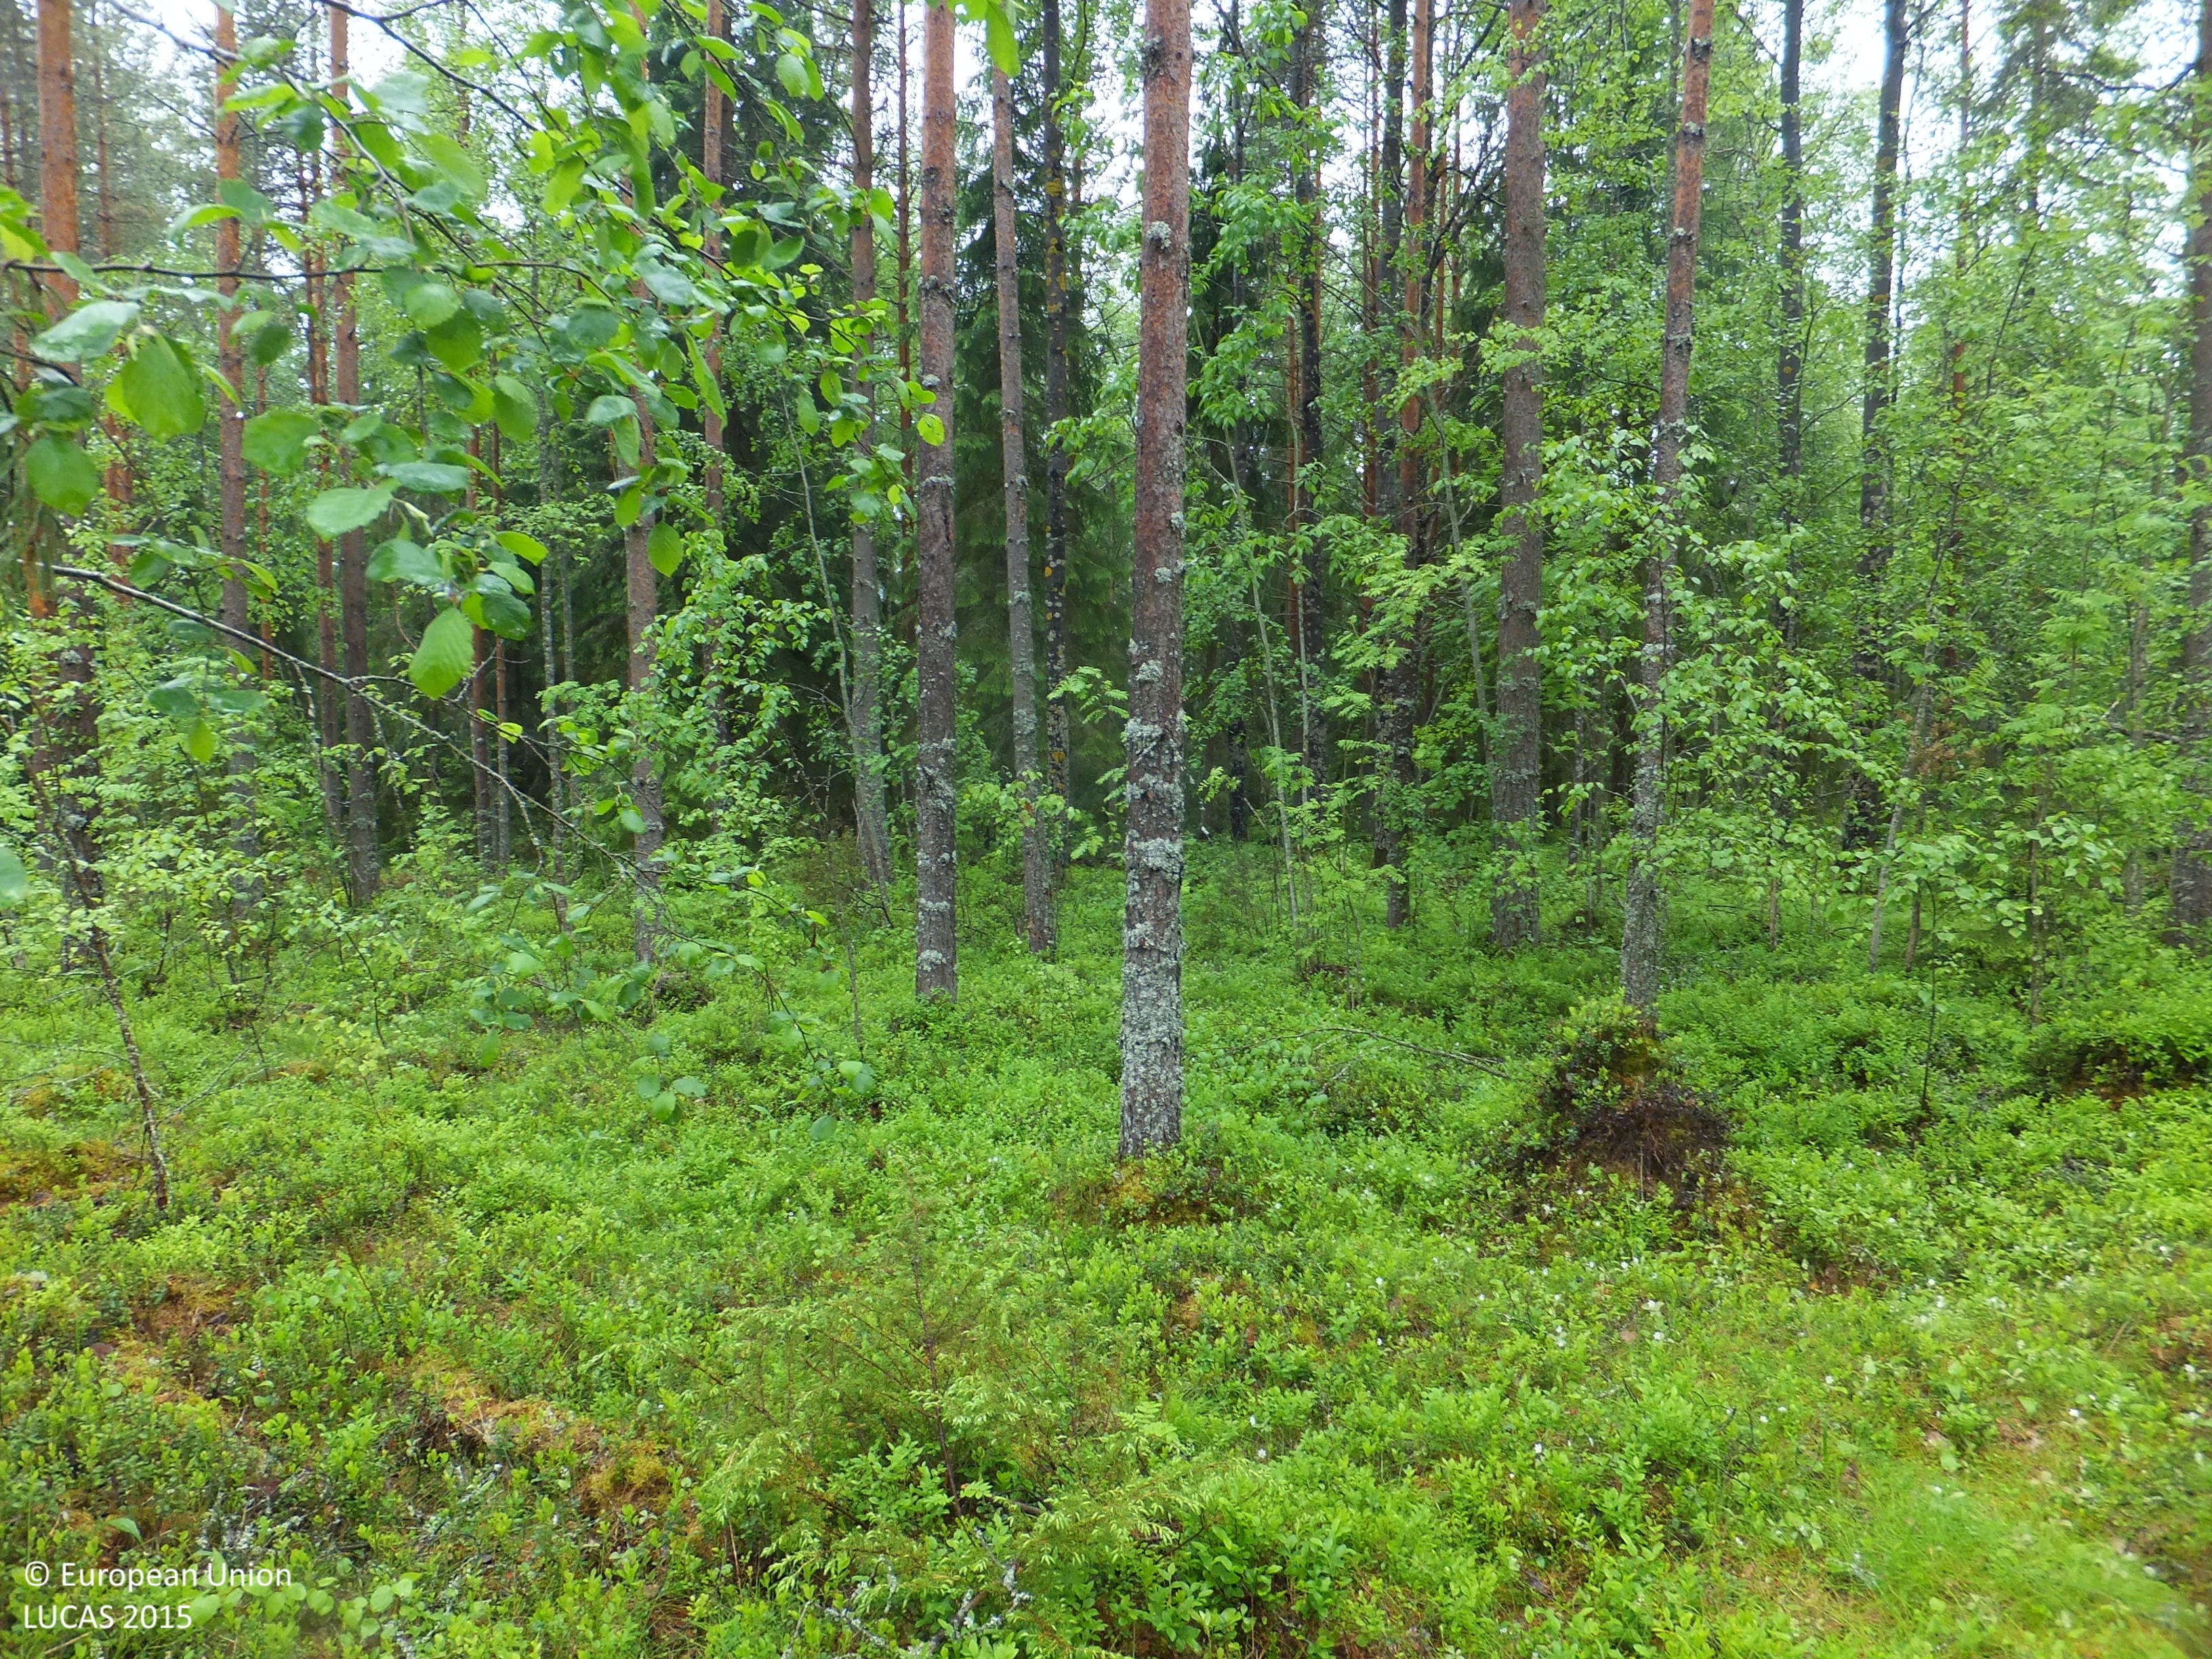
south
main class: Woodland
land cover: Pine dominated coniferous woodland
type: boreal forest
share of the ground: > 75 %
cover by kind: coniferous forest trees 80 %, shrubs 10 %, broadleaved forest trees 5 %, lichens and mosses 5 %
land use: Forestry
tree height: > 5 m
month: June
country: FI
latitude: 63.3296
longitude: 24.8050
